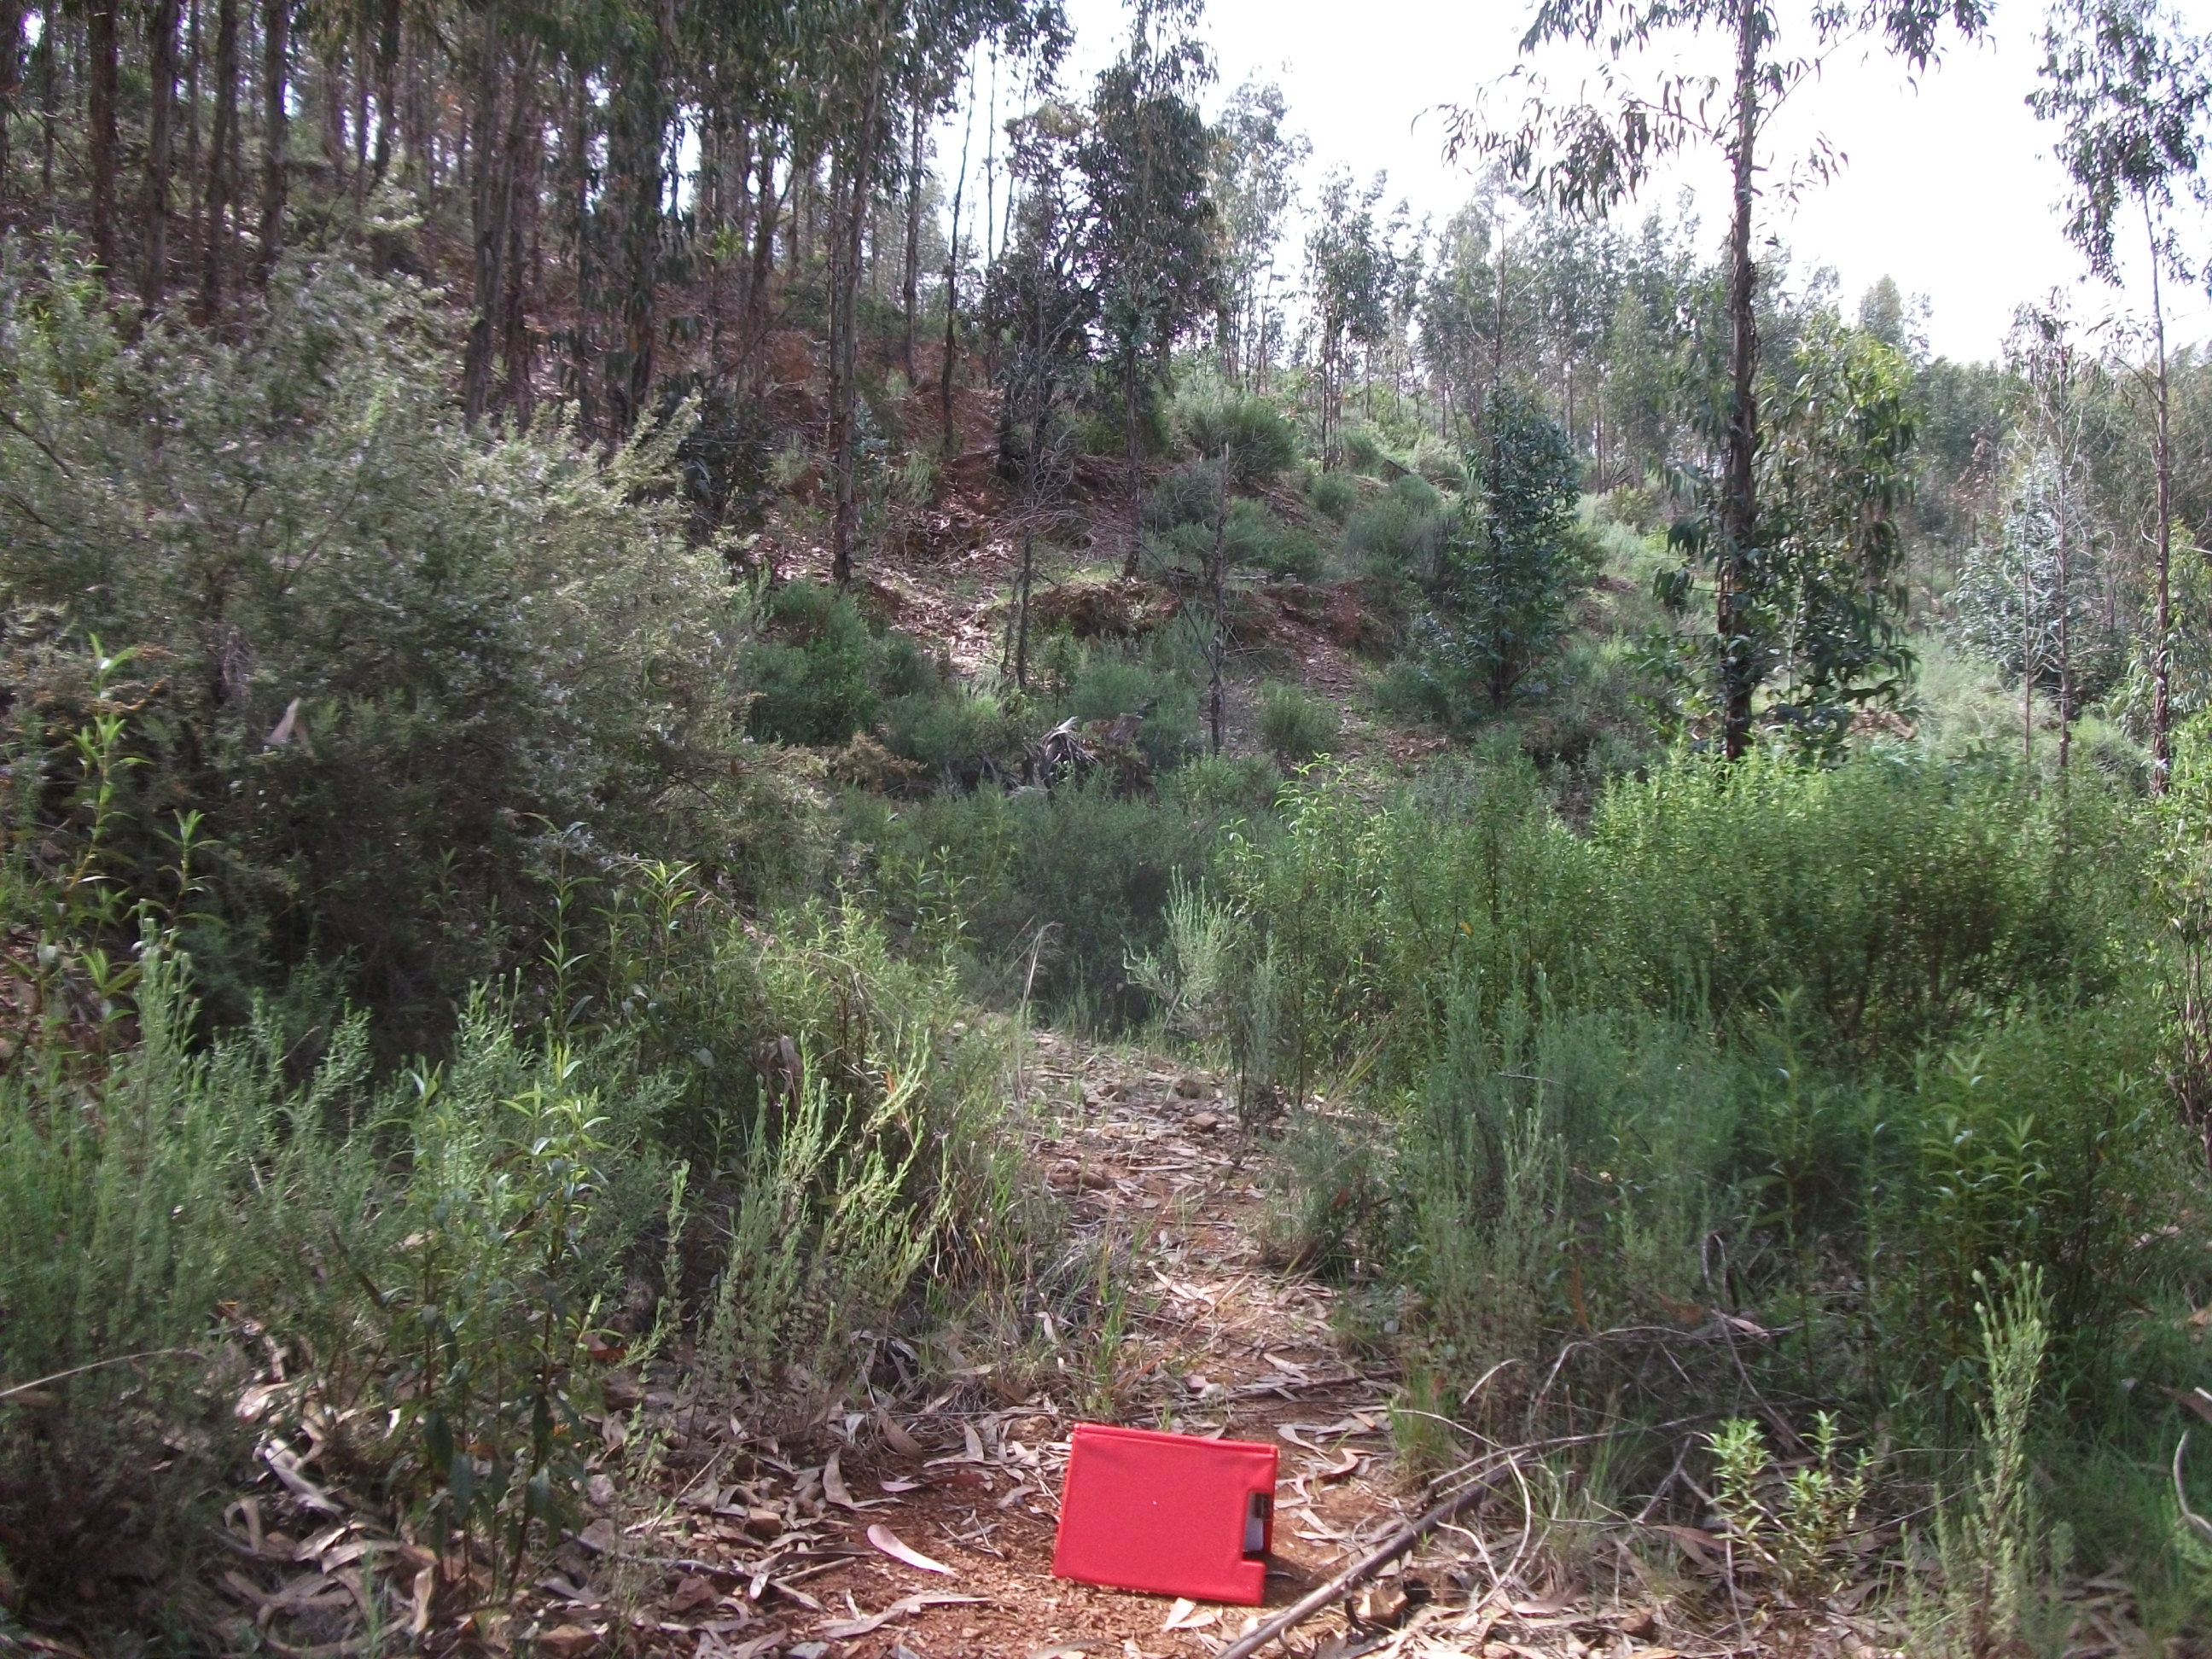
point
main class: Woodland
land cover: Broadleaved woodland
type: broadleaved evergreen forest
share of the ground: 25 - 50 %
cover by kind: shrubs 50 %, broadleaved forest trees 40 %
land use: Forestry
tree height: > 5 m
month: April
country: ES
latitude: 37.8304
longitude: -6.4812
